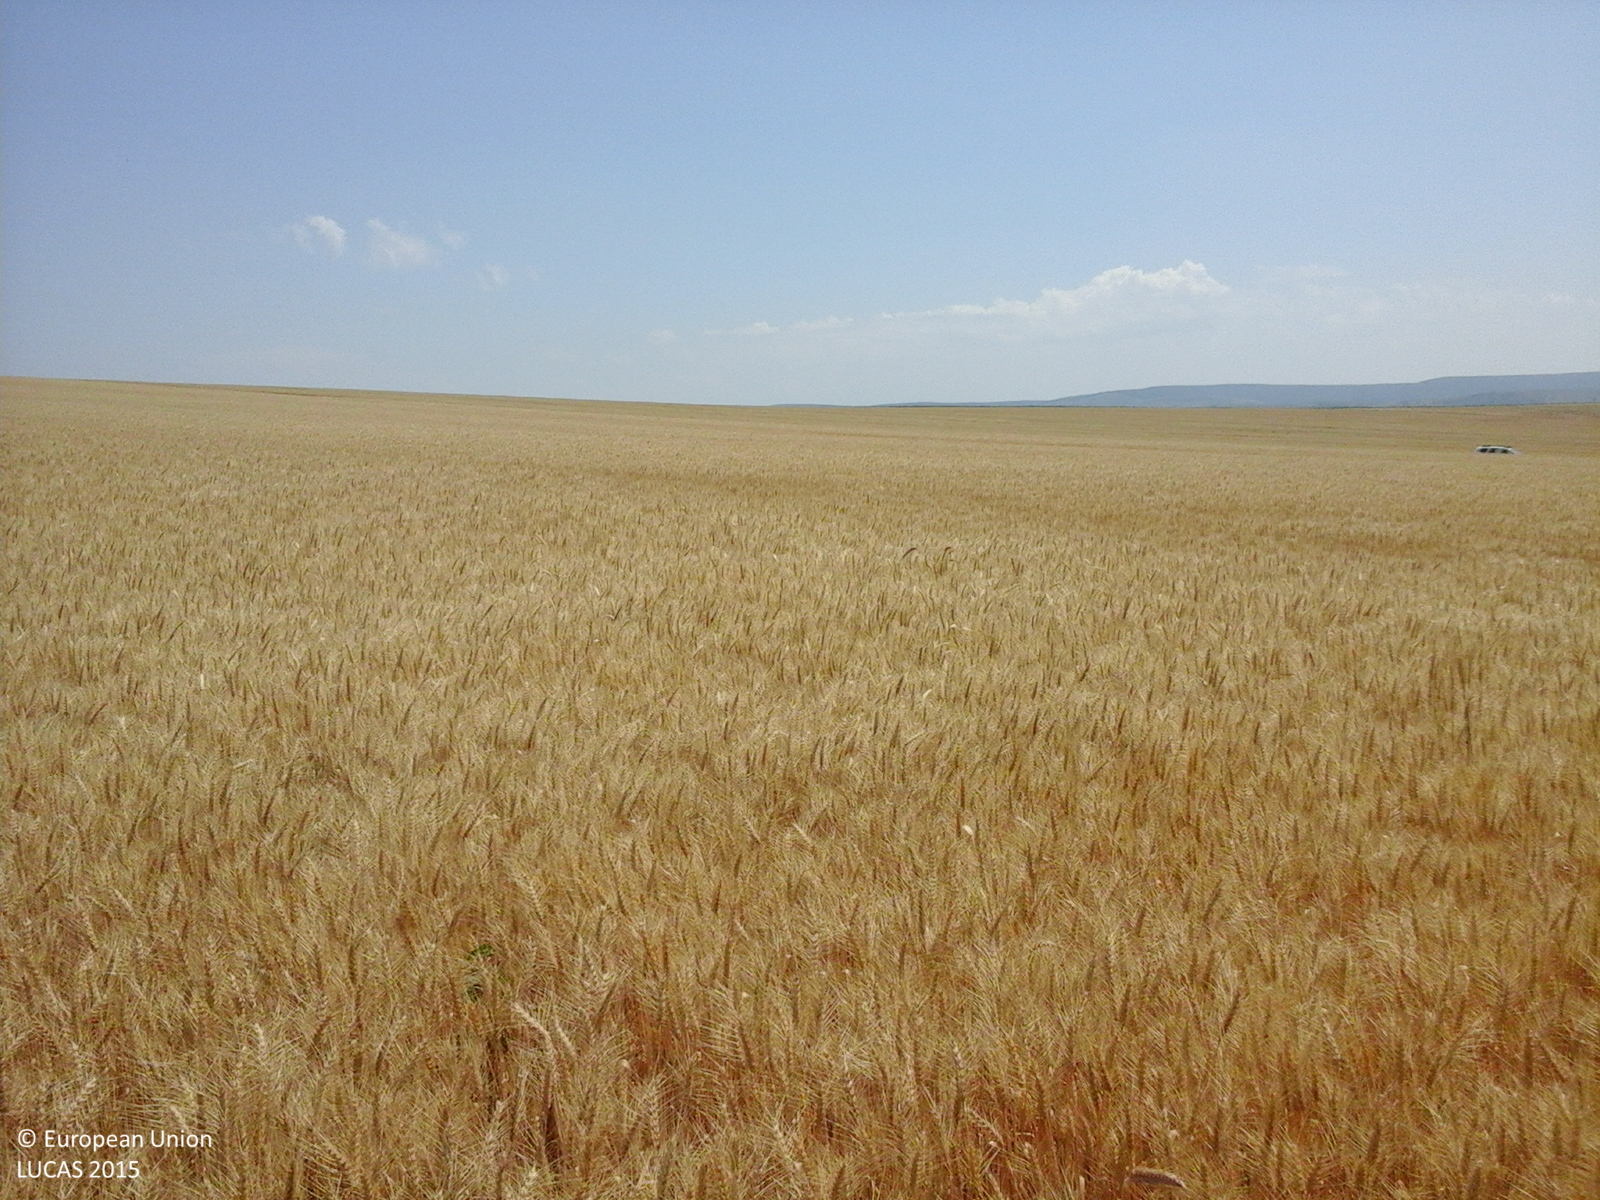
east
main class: Cropland
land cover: Common wheat
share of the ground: > 75 %
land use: Agriculture (excluding fallow land and kitchen gardens)
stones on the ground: < 10 %
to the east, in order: Common wheat; Paved roads, cycling and walking lanes; Common wheat
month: June
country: RO
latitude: 46.6748
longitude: 27.8623
